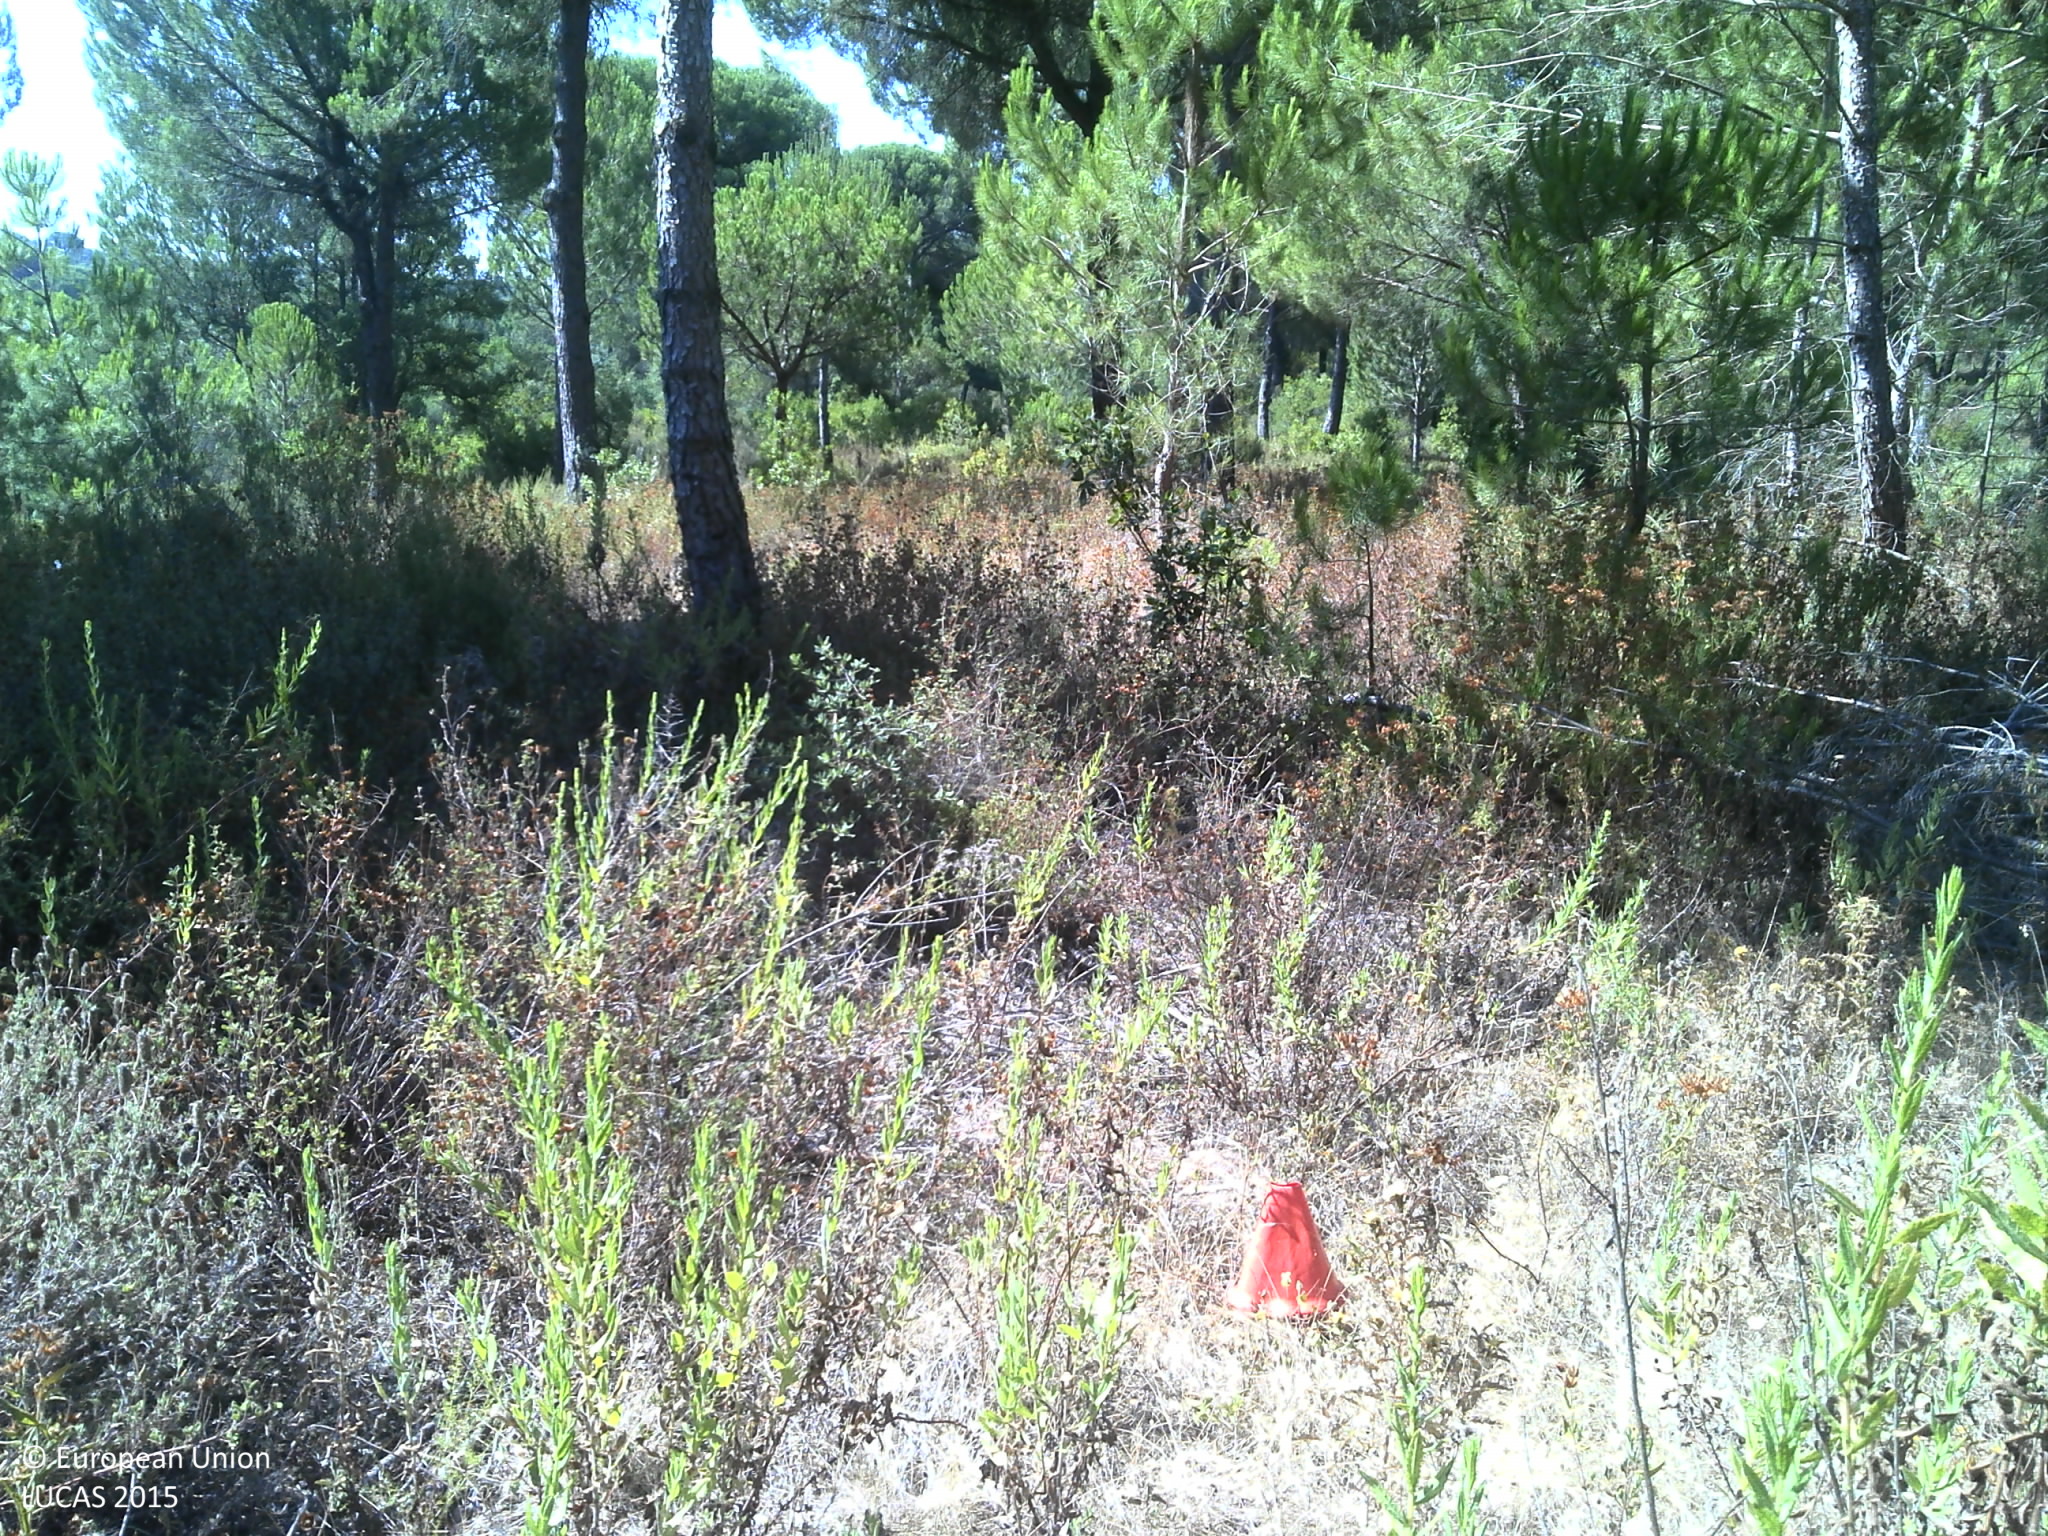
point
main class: Woodland
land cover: Pine dominated coniferous woodland
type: coniferous forest of the mediterranean region
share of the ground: 25 - 50 %
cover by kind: coniferous forest trees 45 %, unconsolidated bare surface 30 %, herbaceous plants 15 %, shrubs 10 %
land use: Forestry
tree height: > 5 m
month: August
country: PT
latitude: 38.6440
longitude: -8.5670
